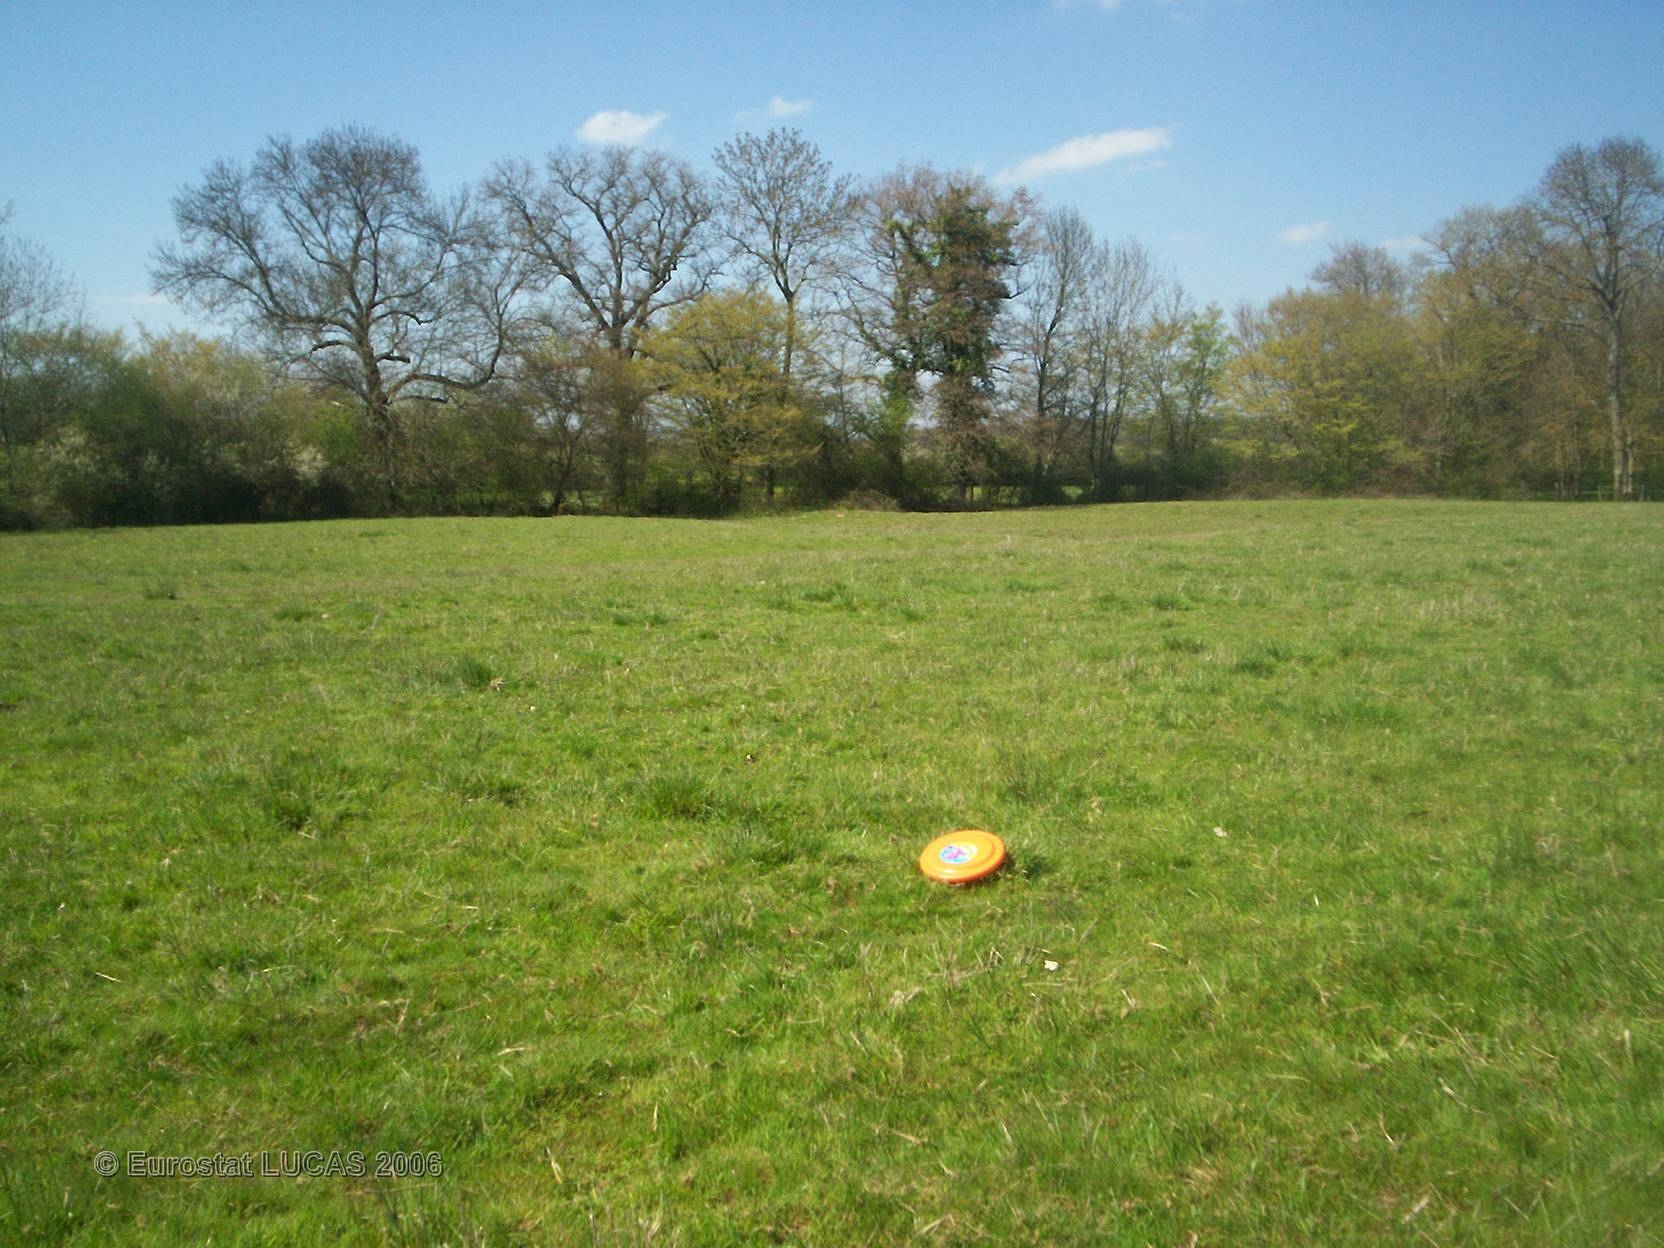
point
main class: Grassland
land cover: Grassland without tree/shrub cover
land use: Agriculture (excluding fallow land and kitchen gardens)
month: April
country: FR
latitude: 46.6548
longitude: 3.1368
